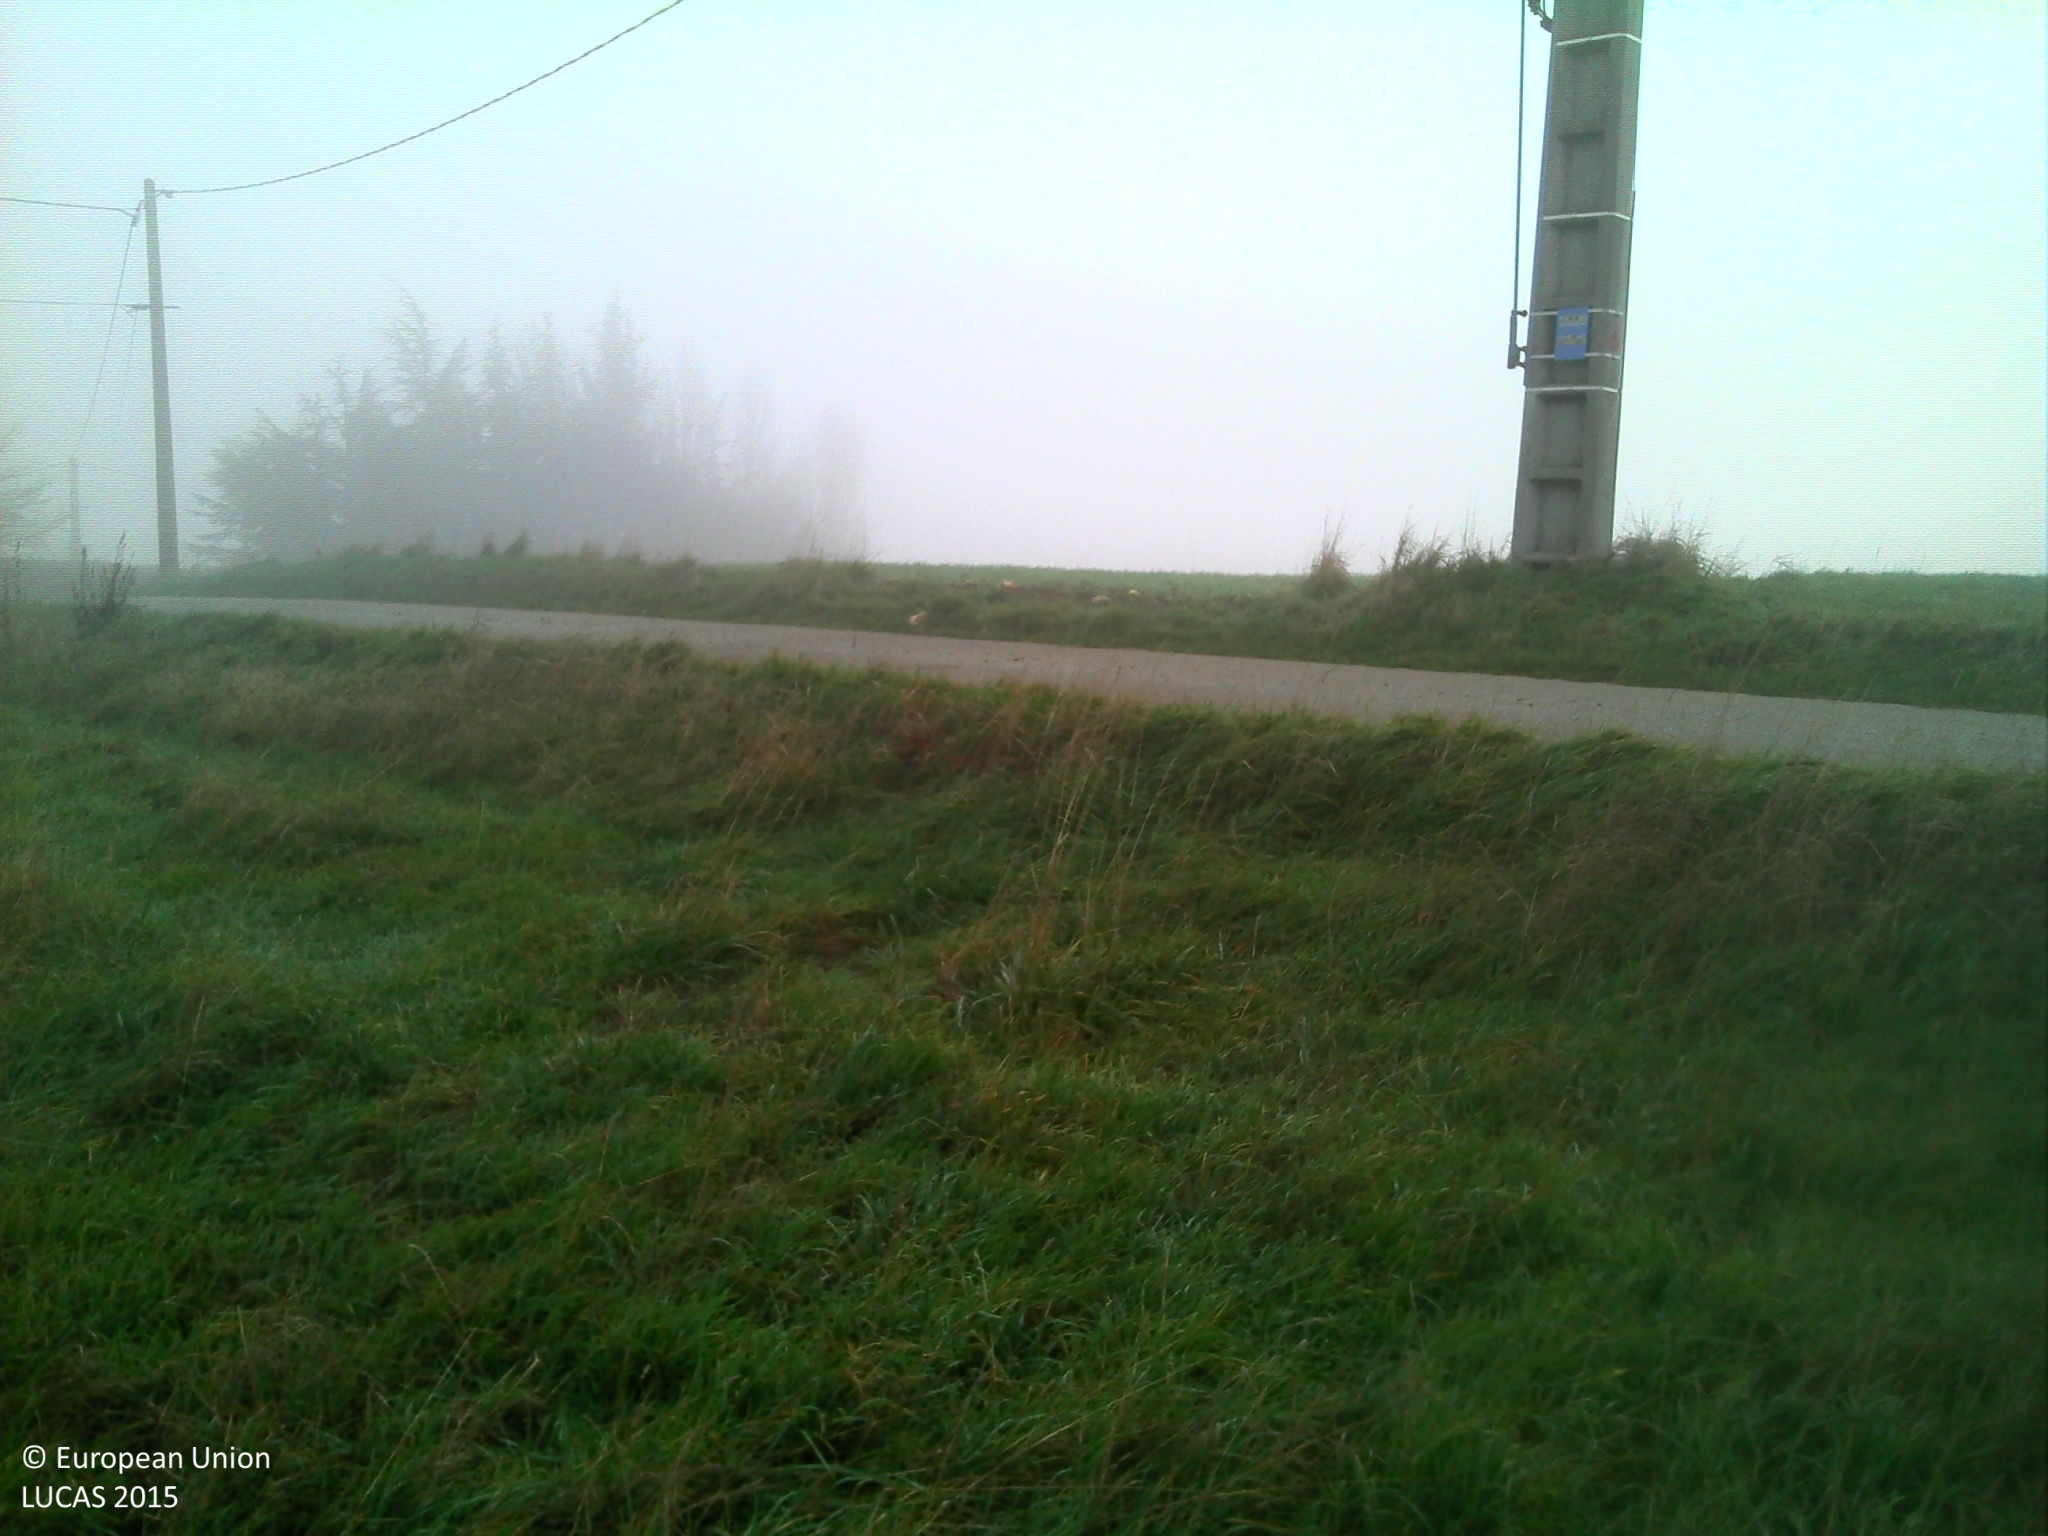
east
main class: Grassland
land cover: Grassland without tree/shrub cover
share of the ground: > 75 %
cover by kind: herbaceous plants 100 %
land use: Agriculture (excluding fallow land and kitchen gardens)
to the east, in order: Grassland without tree/shrub cover; Paved roads, cycling and walking lanes; Grass margins; Electric lines; Common wheat; Artificial constructions in urban areas; Common wheat; Grass margins; Tracks; Broadleaved woodland
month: December
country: FR
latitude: 45.1707
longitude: 5.0302
